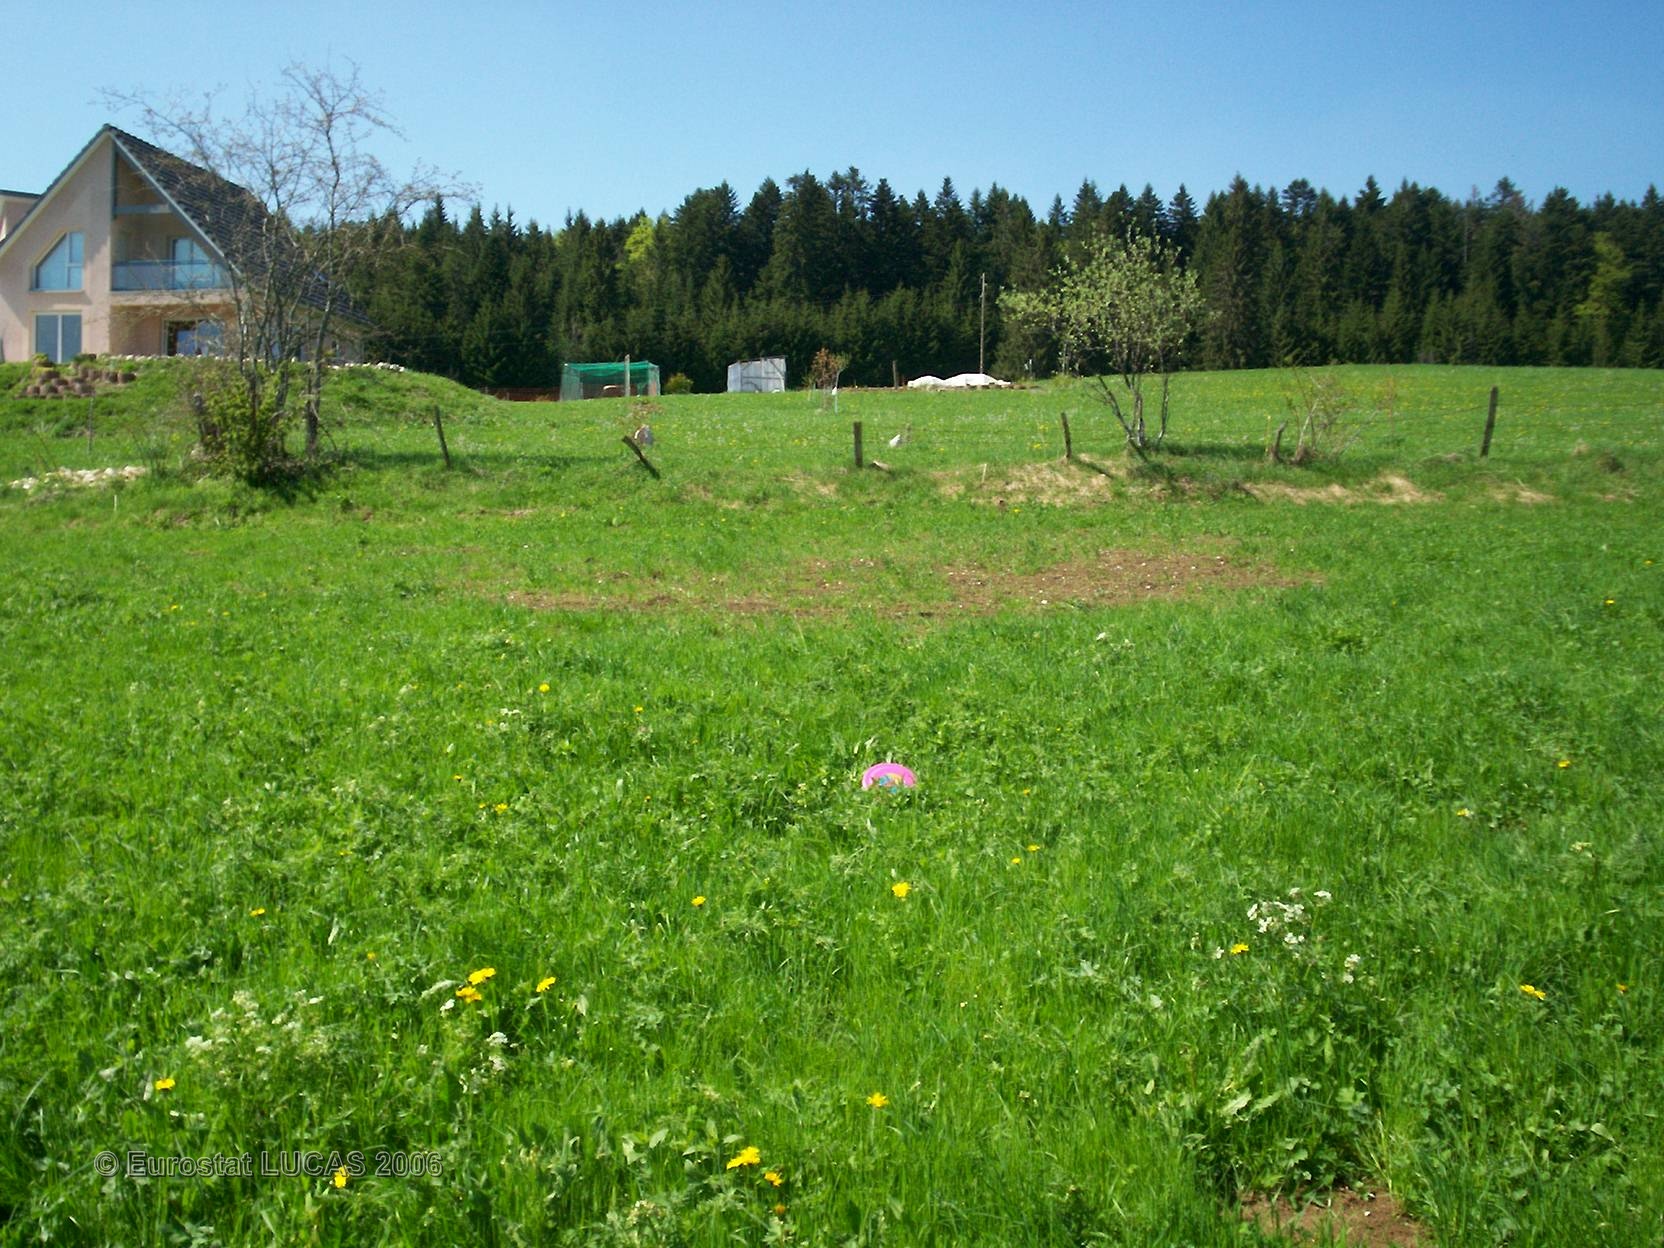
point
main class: Grassland
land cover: Grassland without tree/shrub cover
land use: Agriculture (excluding fallow land and kitchen gardens)
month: May
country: FR
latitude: 47.0744
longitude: 6.6704
